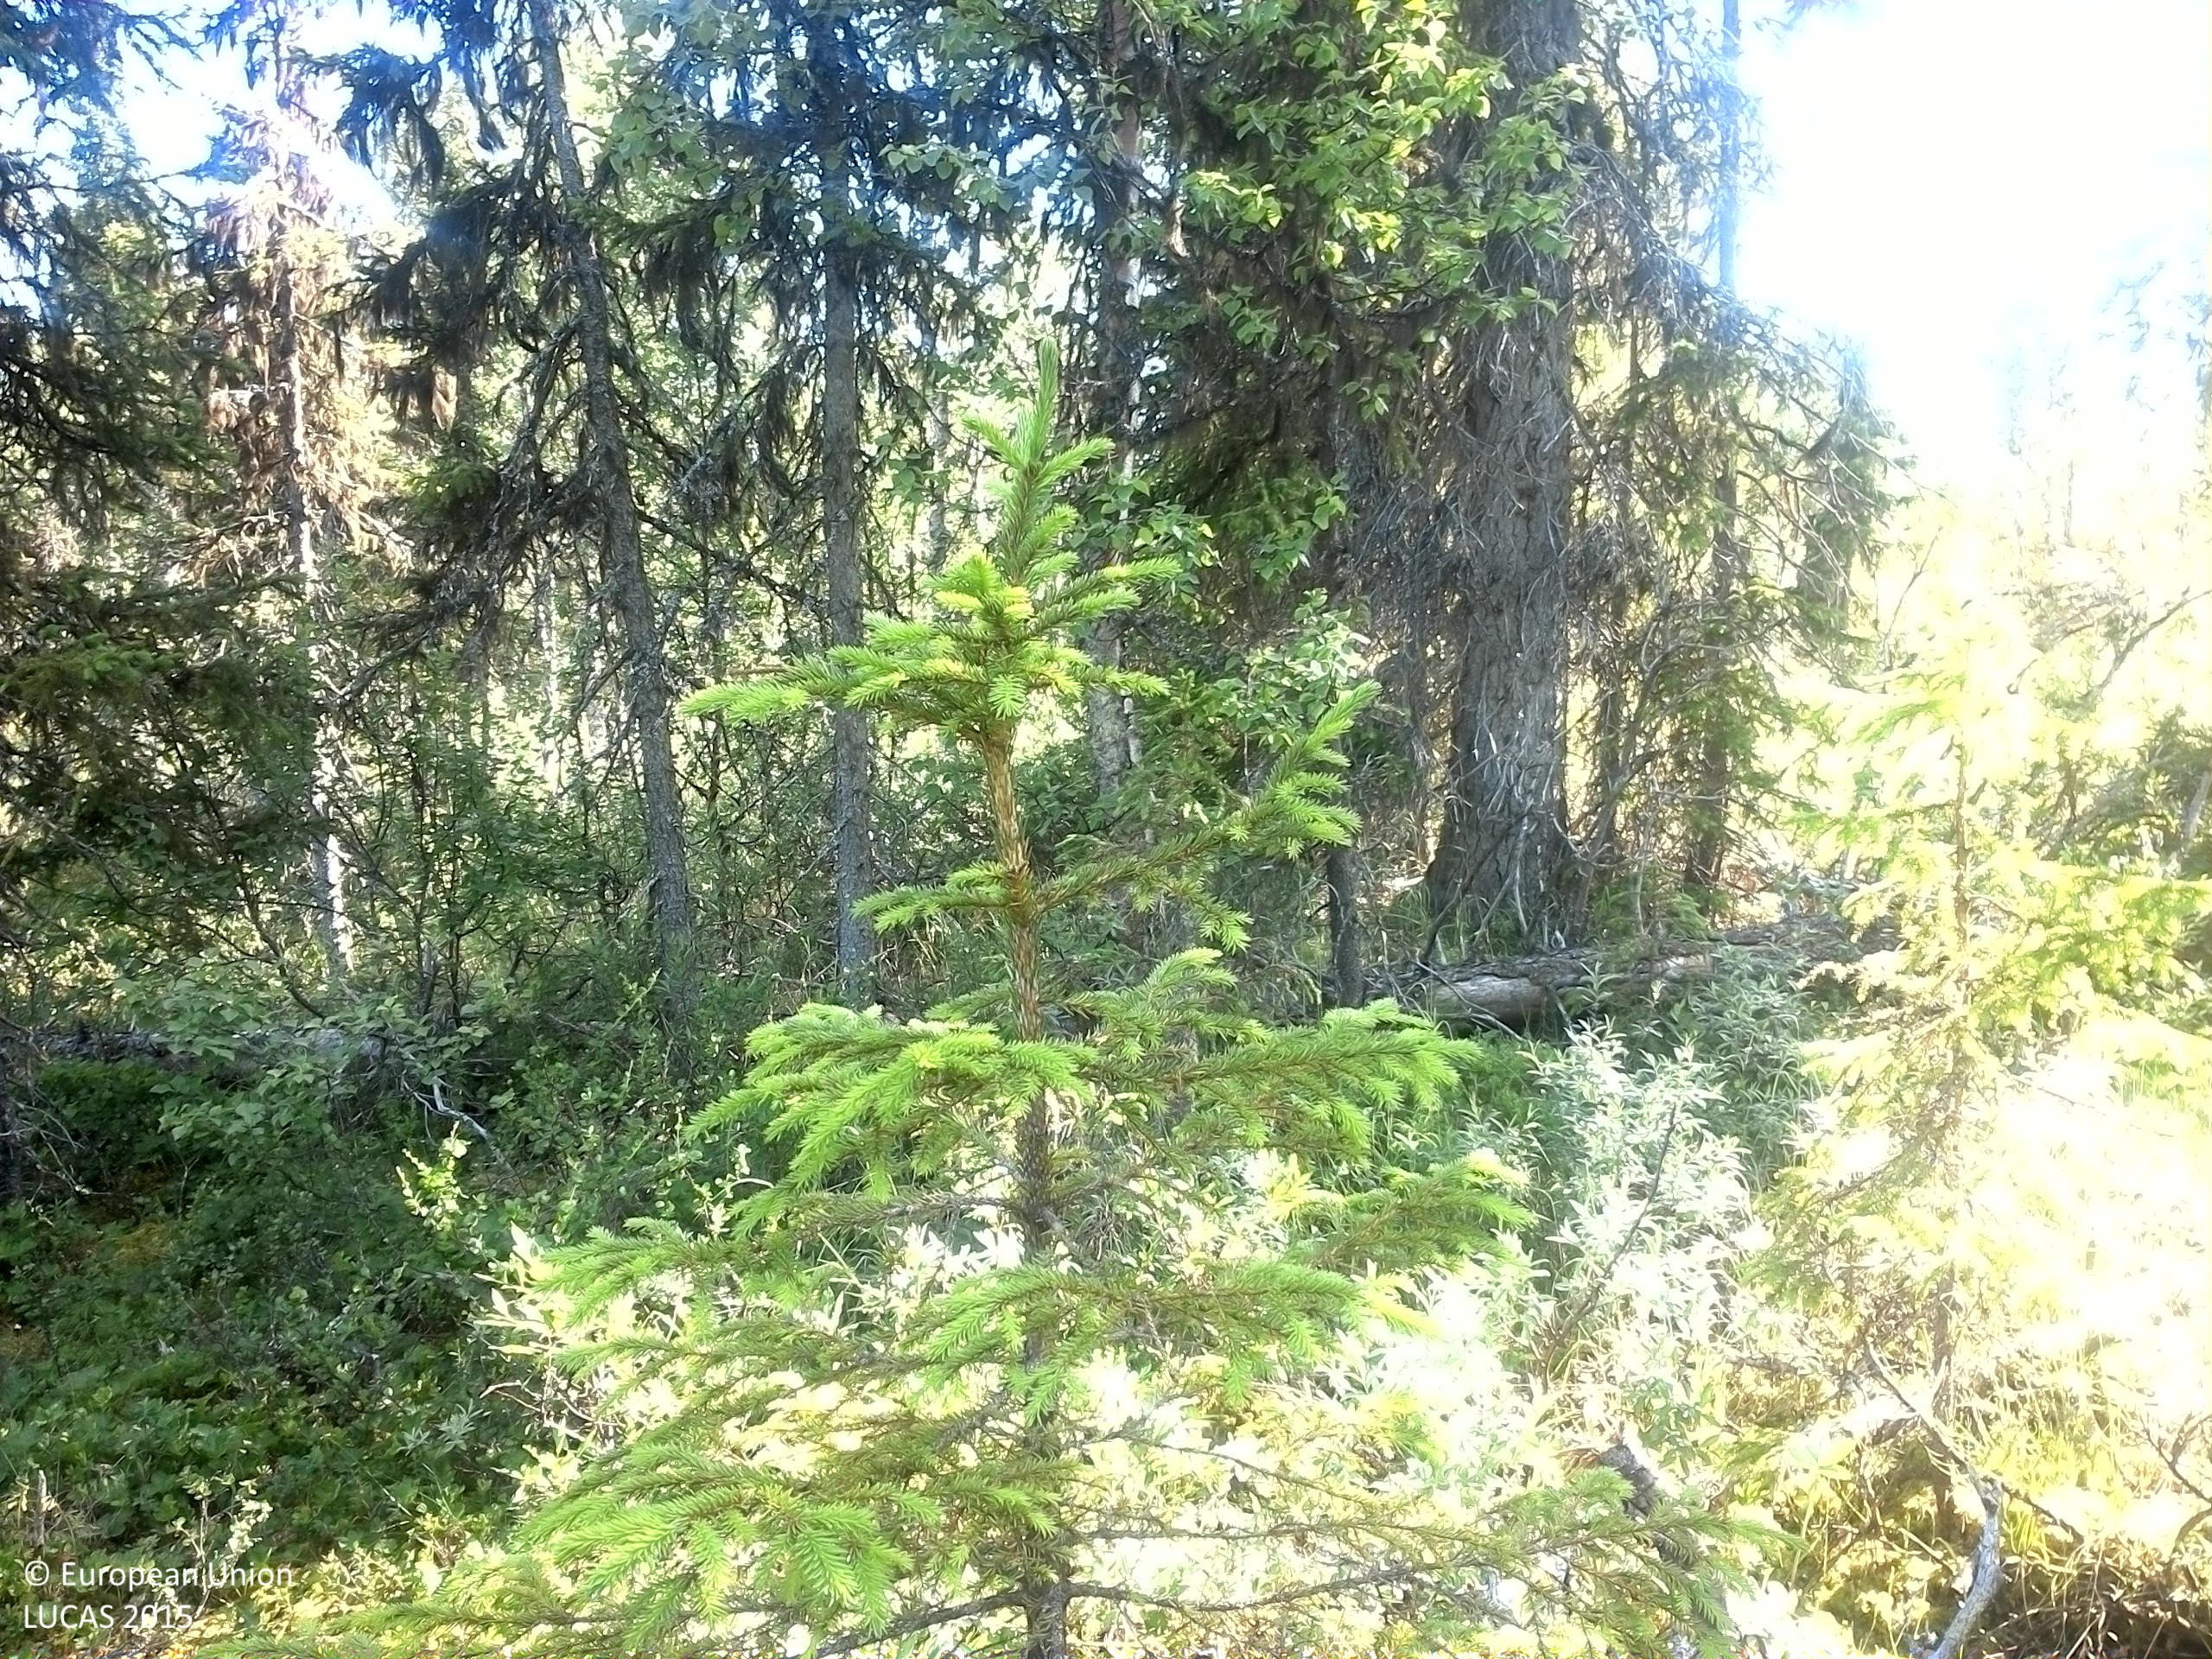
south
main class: Woodland
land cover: Spruce dominated coniferous woodland
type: mire and swamp forests
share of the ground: 25 - 50 %
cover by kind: coniferous forest trees 40 %, shrubs 25 %, lichens and mosses 25 %, broadleaved forest trees 5 %, herbaceous plants 5 %
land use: Semi-natural and natural areas not in use
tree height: > 5 m
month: July
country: SE
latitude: 64.5656
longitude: 15.7496
